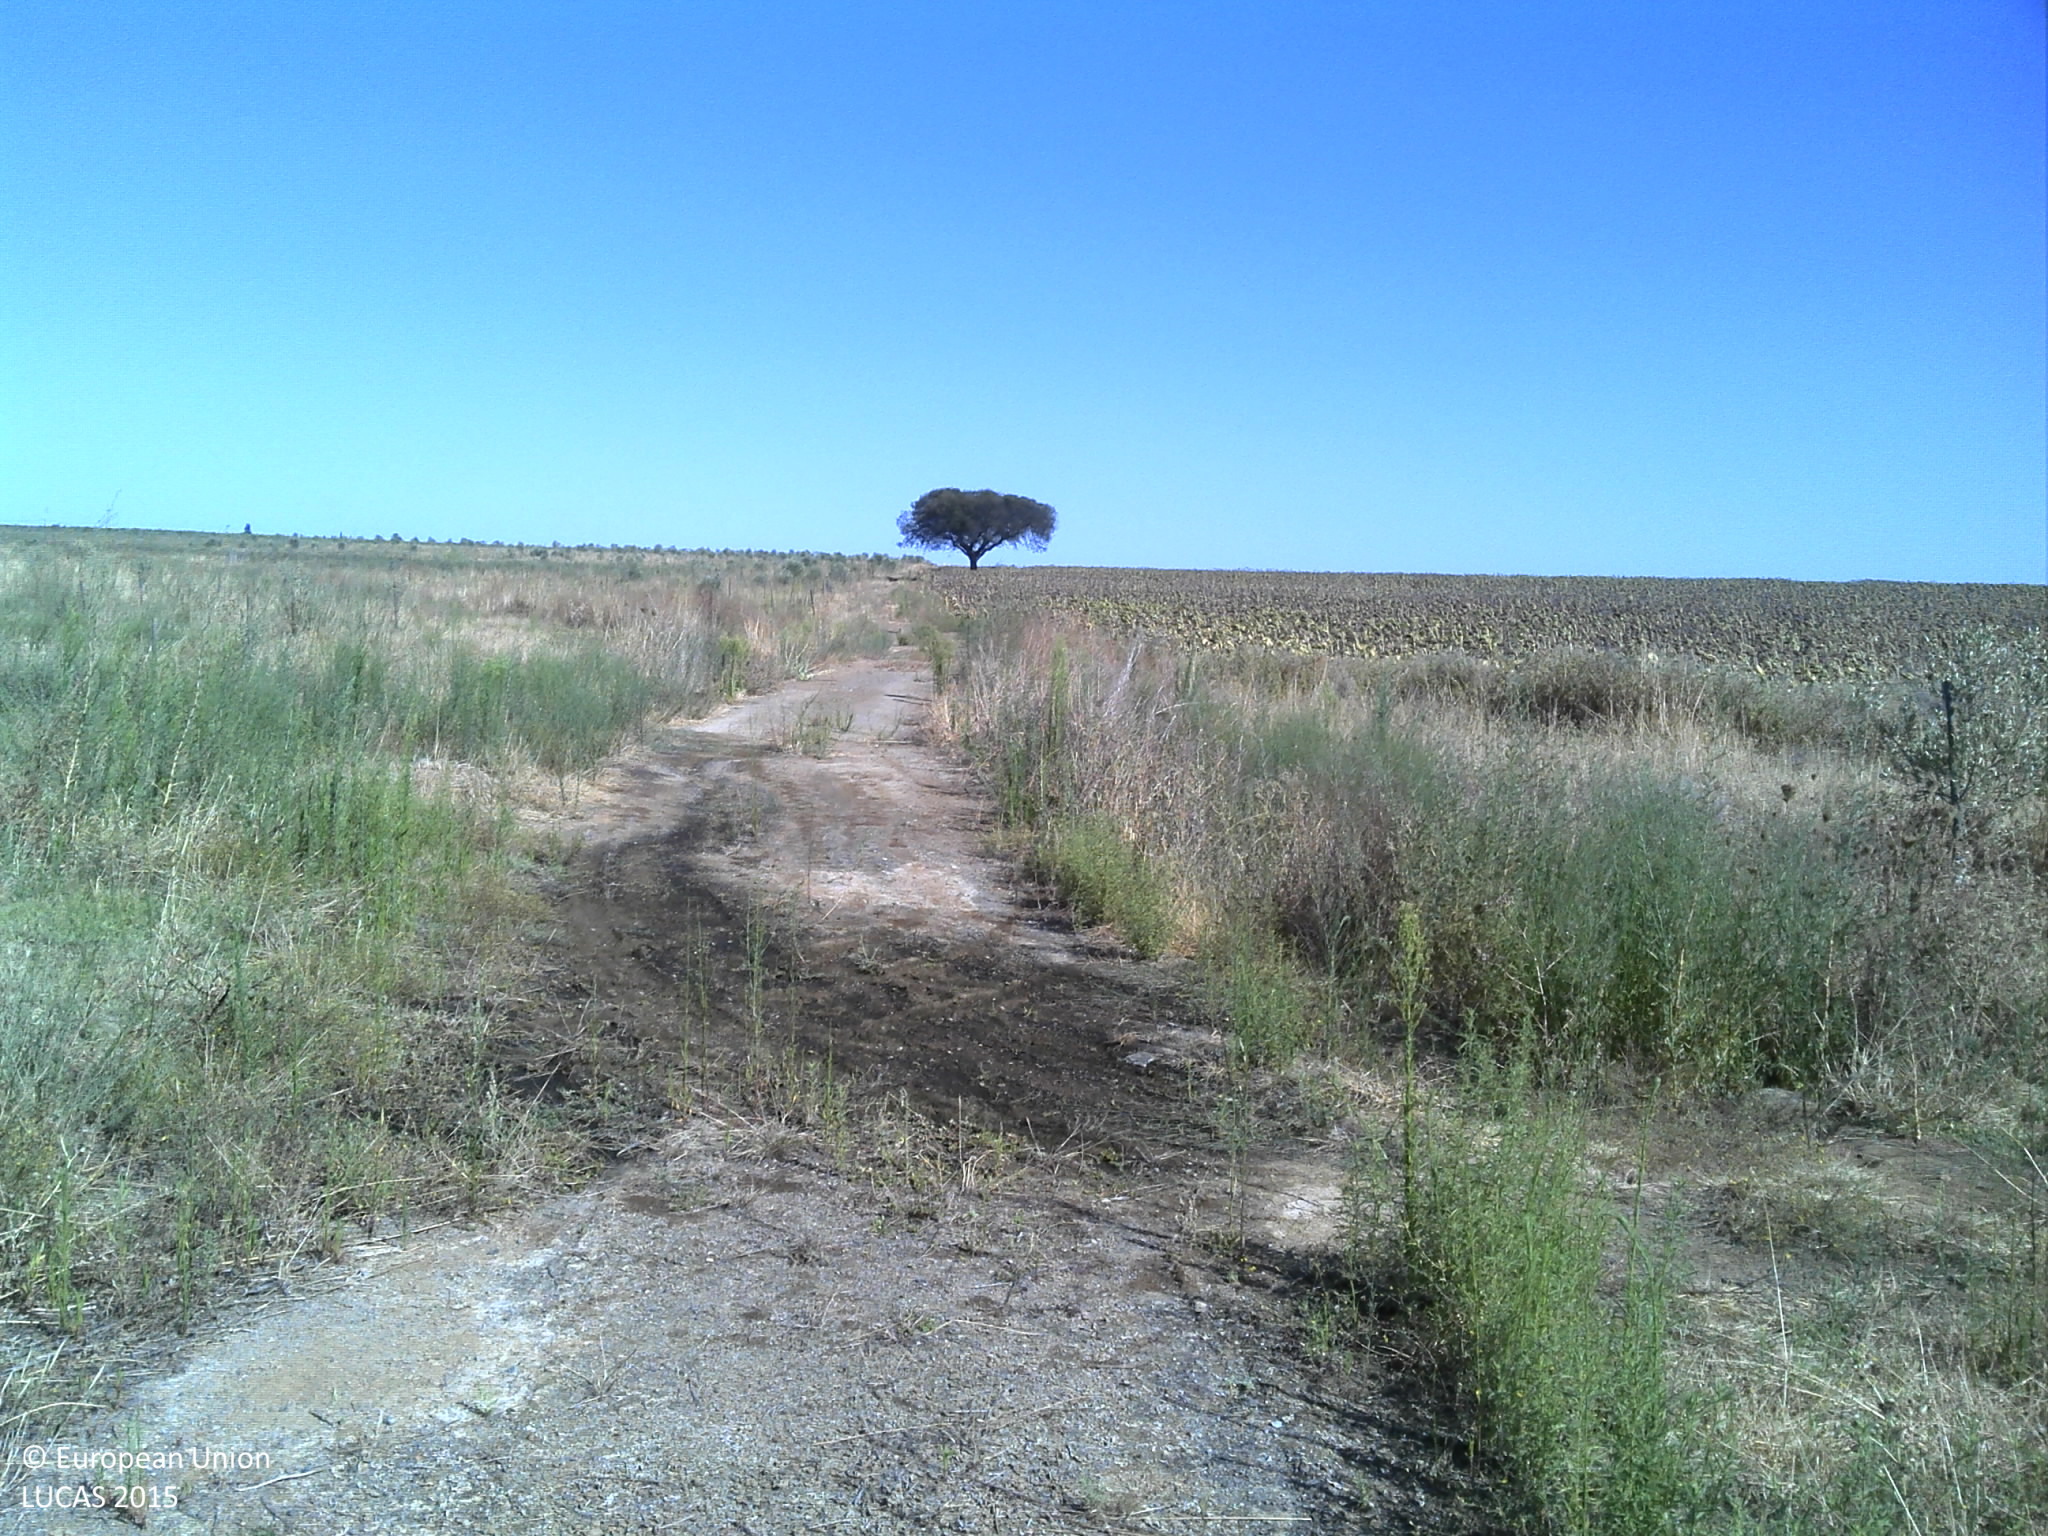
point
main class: Cropland
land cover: Sunflower
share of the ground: 25 - 50 %
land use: Agriculture (excluding fallow land and kitchen gardens)
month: July
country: PT
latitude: 38.0896
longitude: -7.9901
